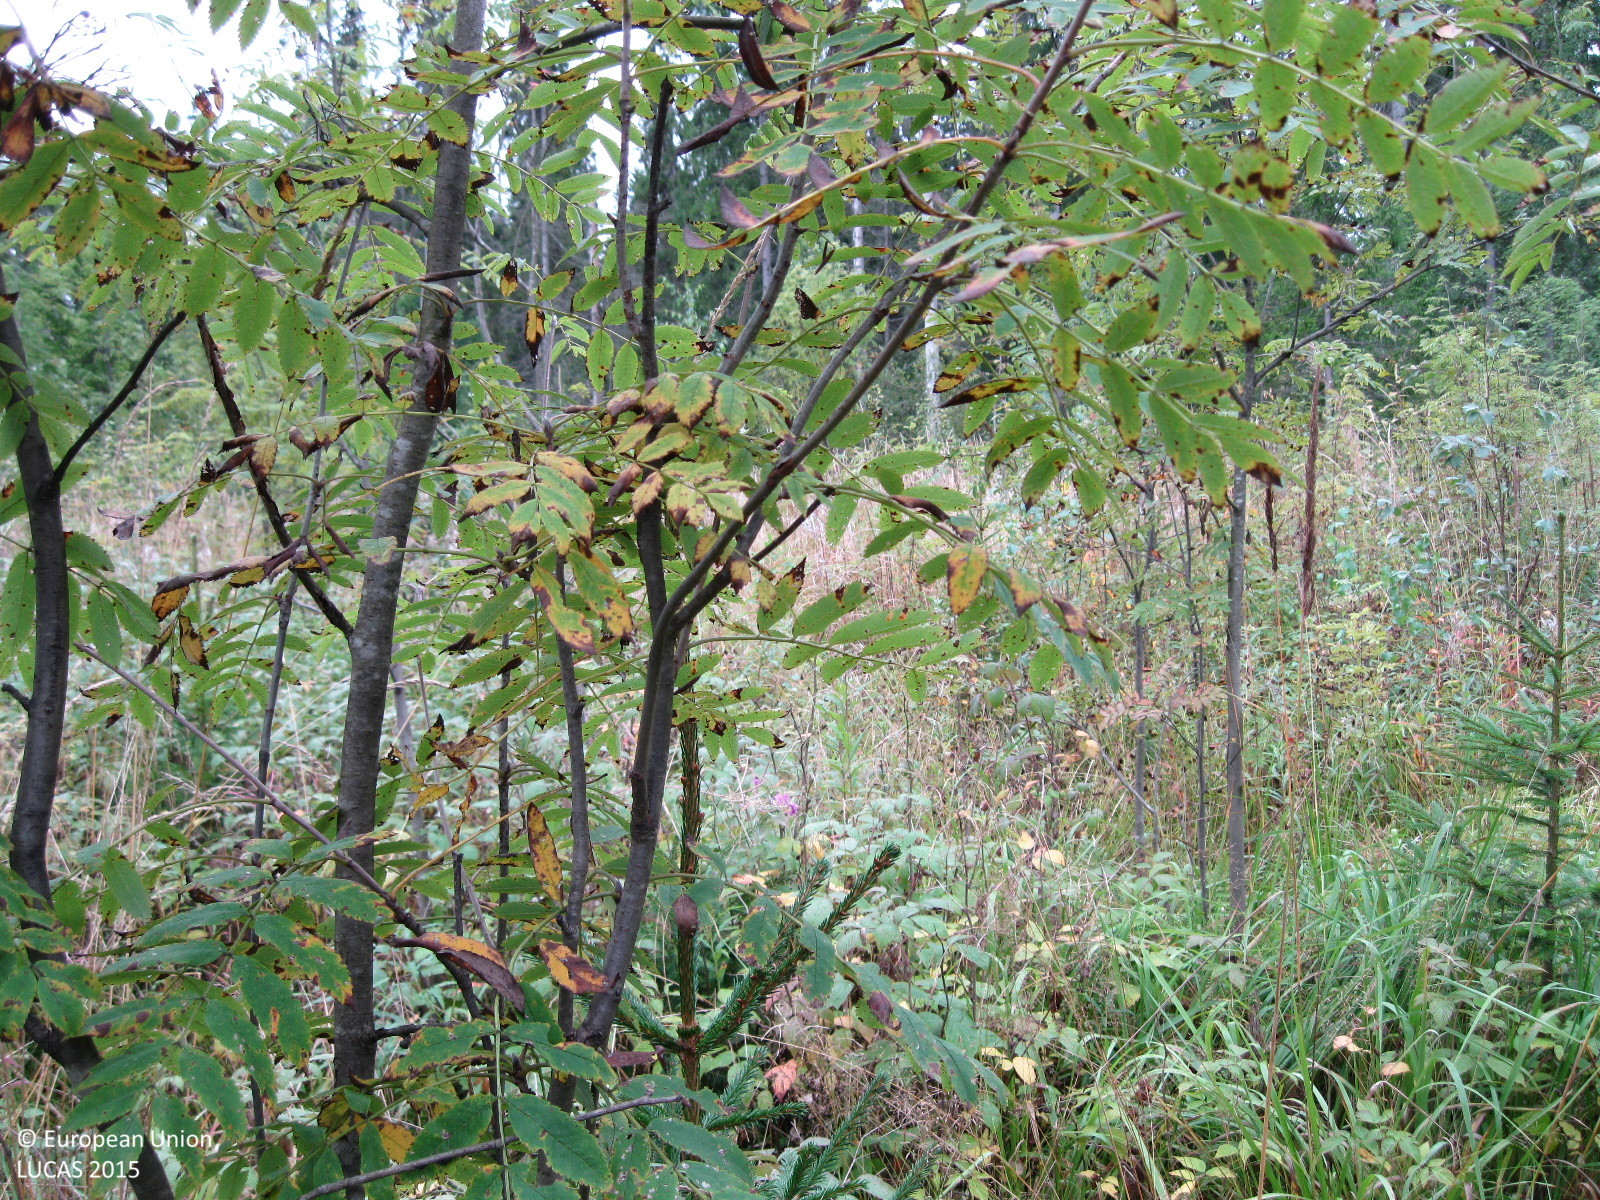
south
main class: Woodland
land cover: Broadleaved woodland
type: boreal forest
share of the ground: > 75 %
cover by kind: broadleaved forest trees 65 %, herbaceous plants 15 %, coniferous forest trees 10 %, shrubs 10 %
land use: Forestry
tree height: > 5 m
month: September
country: FI
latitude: 60.4816
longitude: 24.7592
